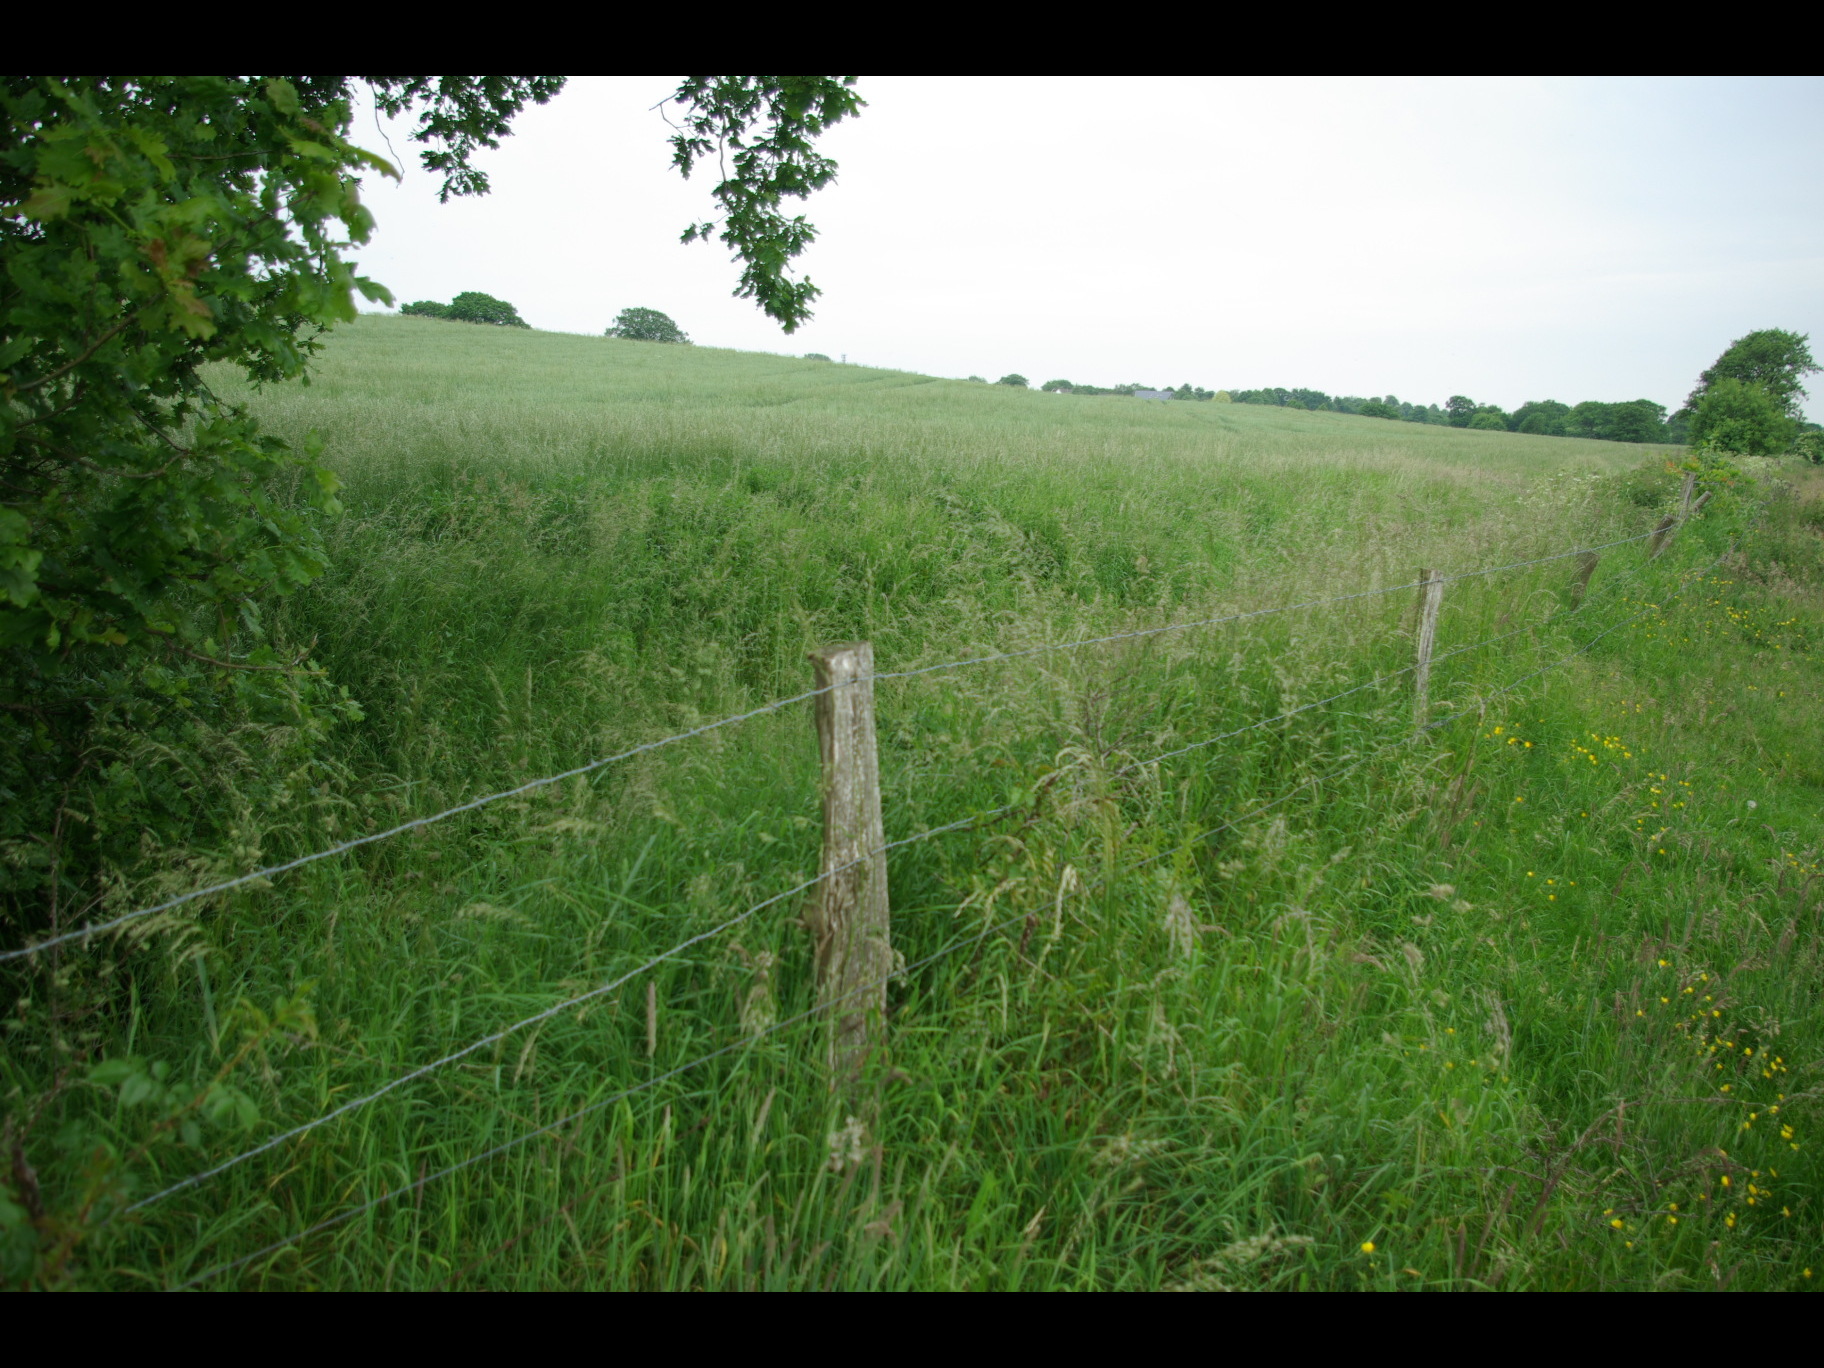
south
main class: Grassland
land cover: Grassland without tree/shrub cover
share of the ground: > 75 %
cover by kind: herbaceous plants 100 %
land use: Agriculture (excluding fallow land and kitchen gardens)
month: June
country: DE
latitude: 54.5341
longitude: 9.8919
